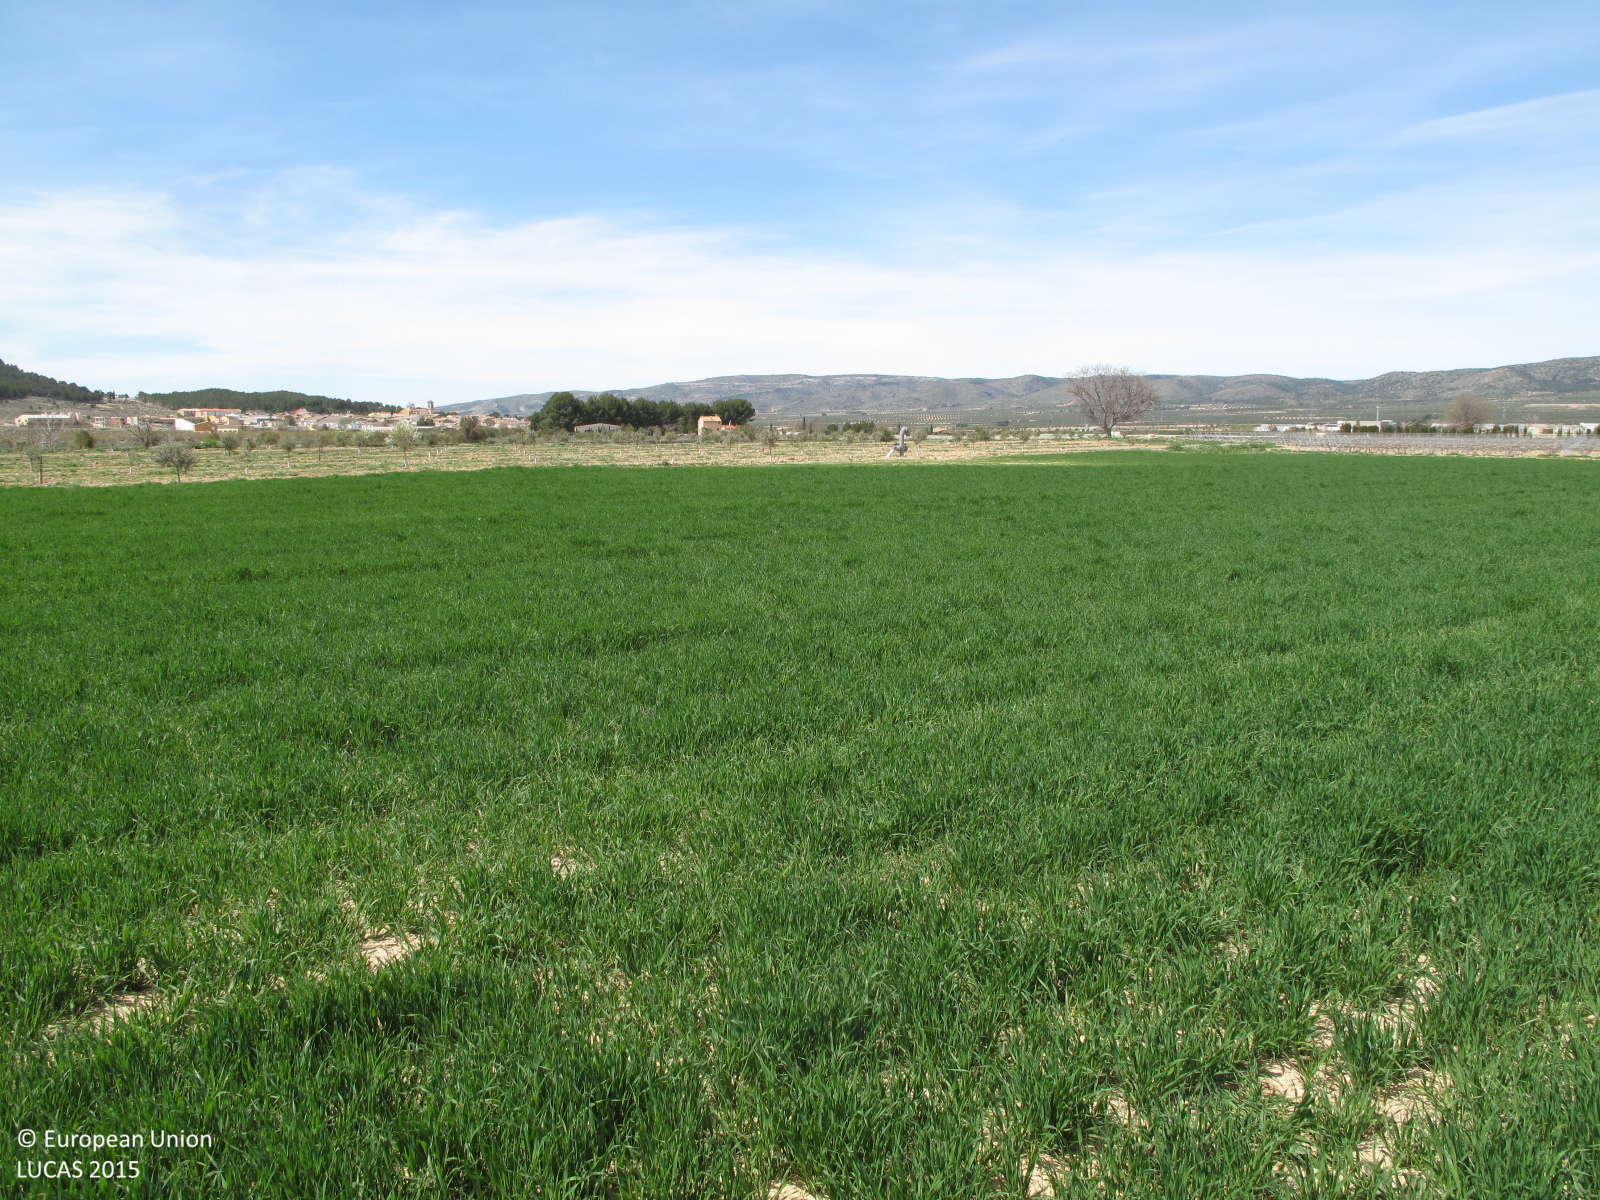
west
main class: Cropland
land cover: Barley
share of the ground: > 75 %
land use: Agriculture (excluding fallow land and kitchen gardens)
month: March
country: ES
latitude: 38.6880
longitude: -0.7625
